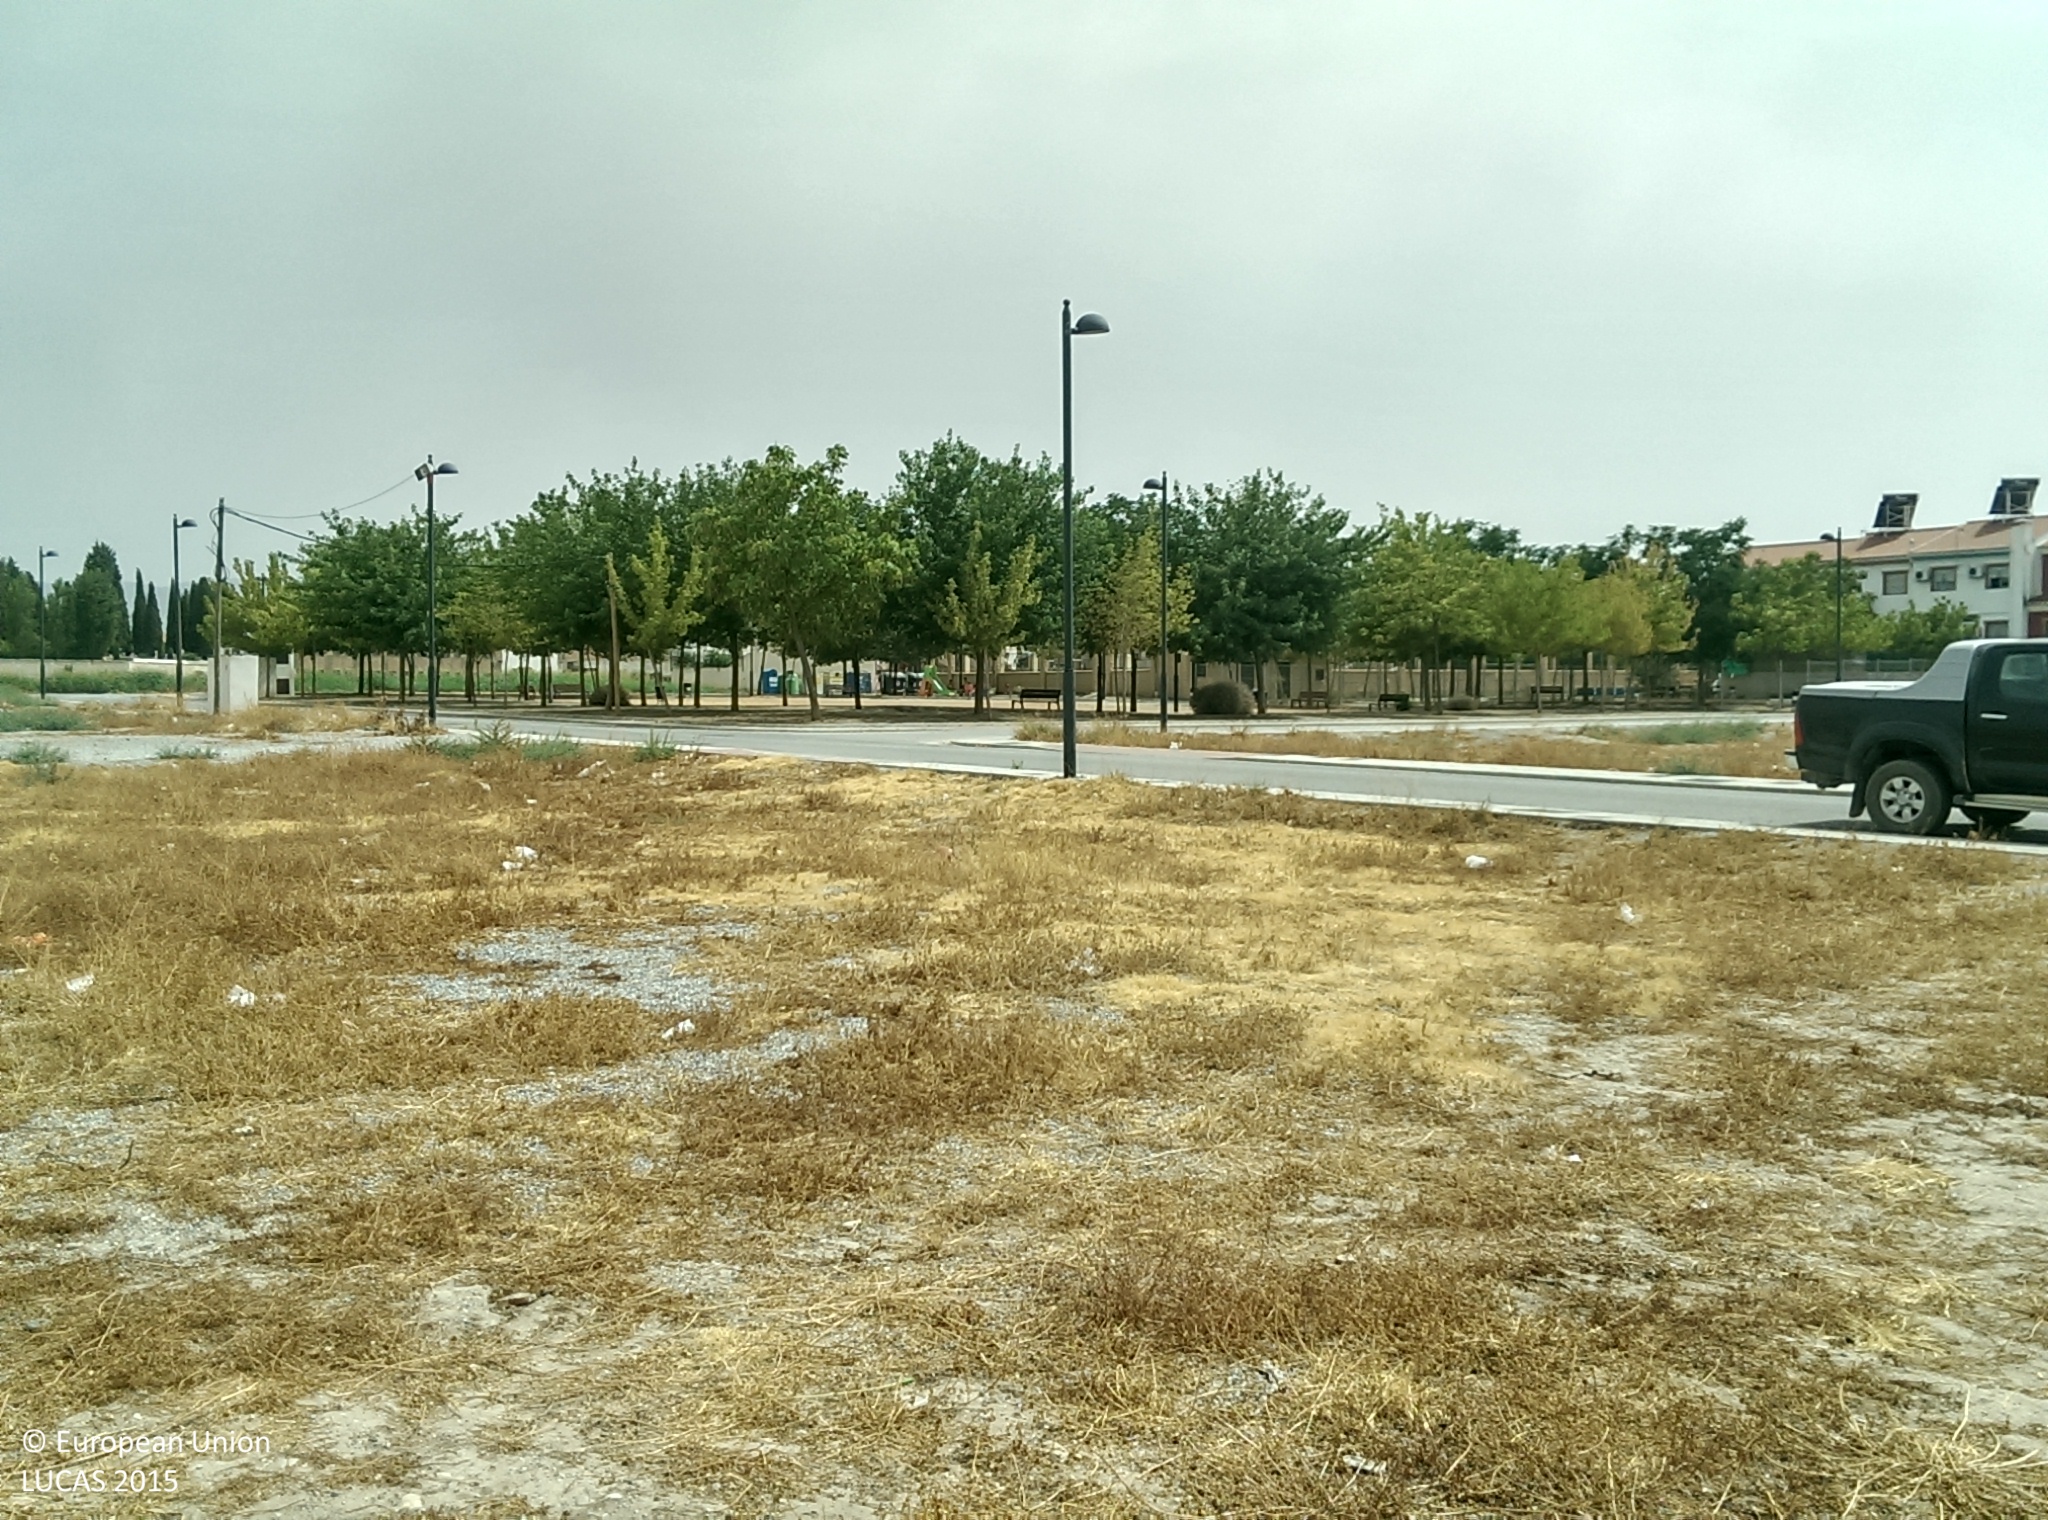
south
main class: Grassland
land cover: Grassland without tree/shrub cover
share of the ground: 10 - 25 %
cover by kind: unconsolidated bare surface 85 %, herbaceous plants 15 %
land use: Residential
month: August
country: ES
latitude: 37.1592
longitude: -3.6712
